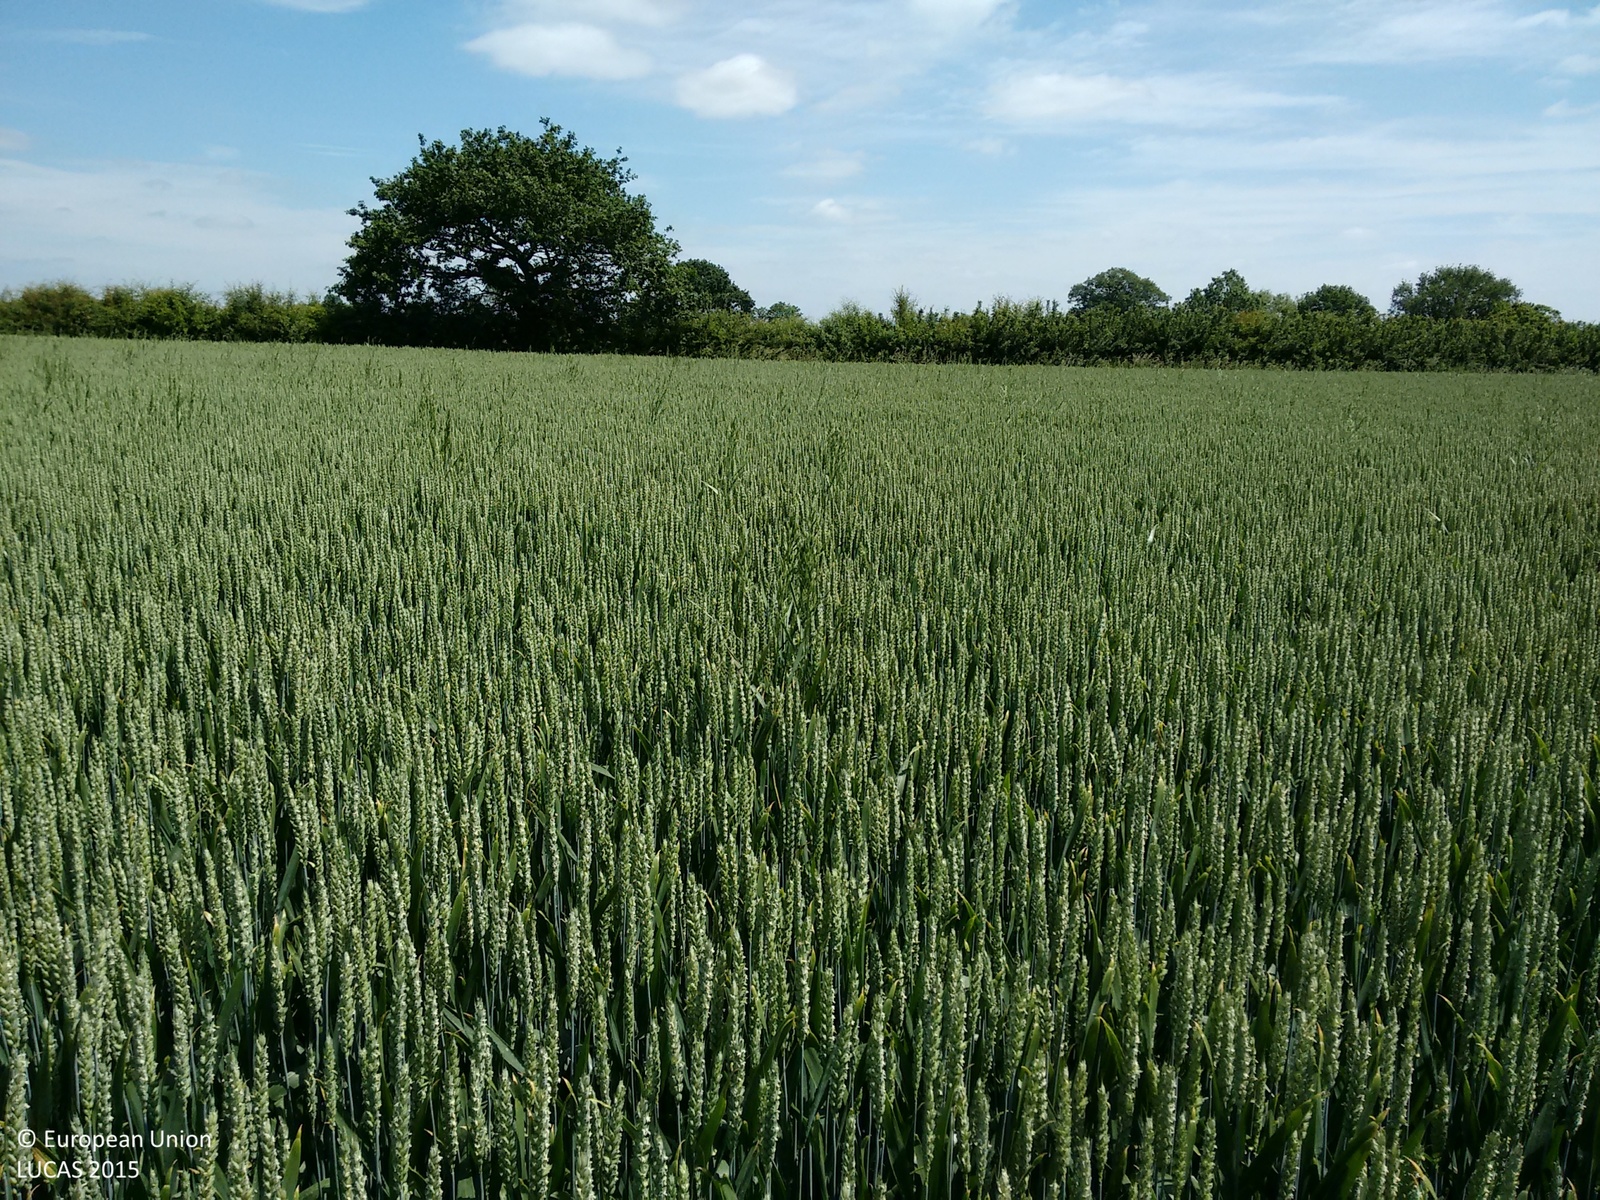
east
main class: Cropland
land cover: Common wheat
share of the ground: > 75 %
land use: Agriculture (excluding fallow land and kitchen gardens)
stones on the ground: < 10 %
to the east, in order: Common wheat; Grass margins; Managed hedges; Grass margins; Common wheat; Grass margins; Managed hedges; Common wheat
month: June
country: GB
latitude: 51.8391
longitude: -1.2671
